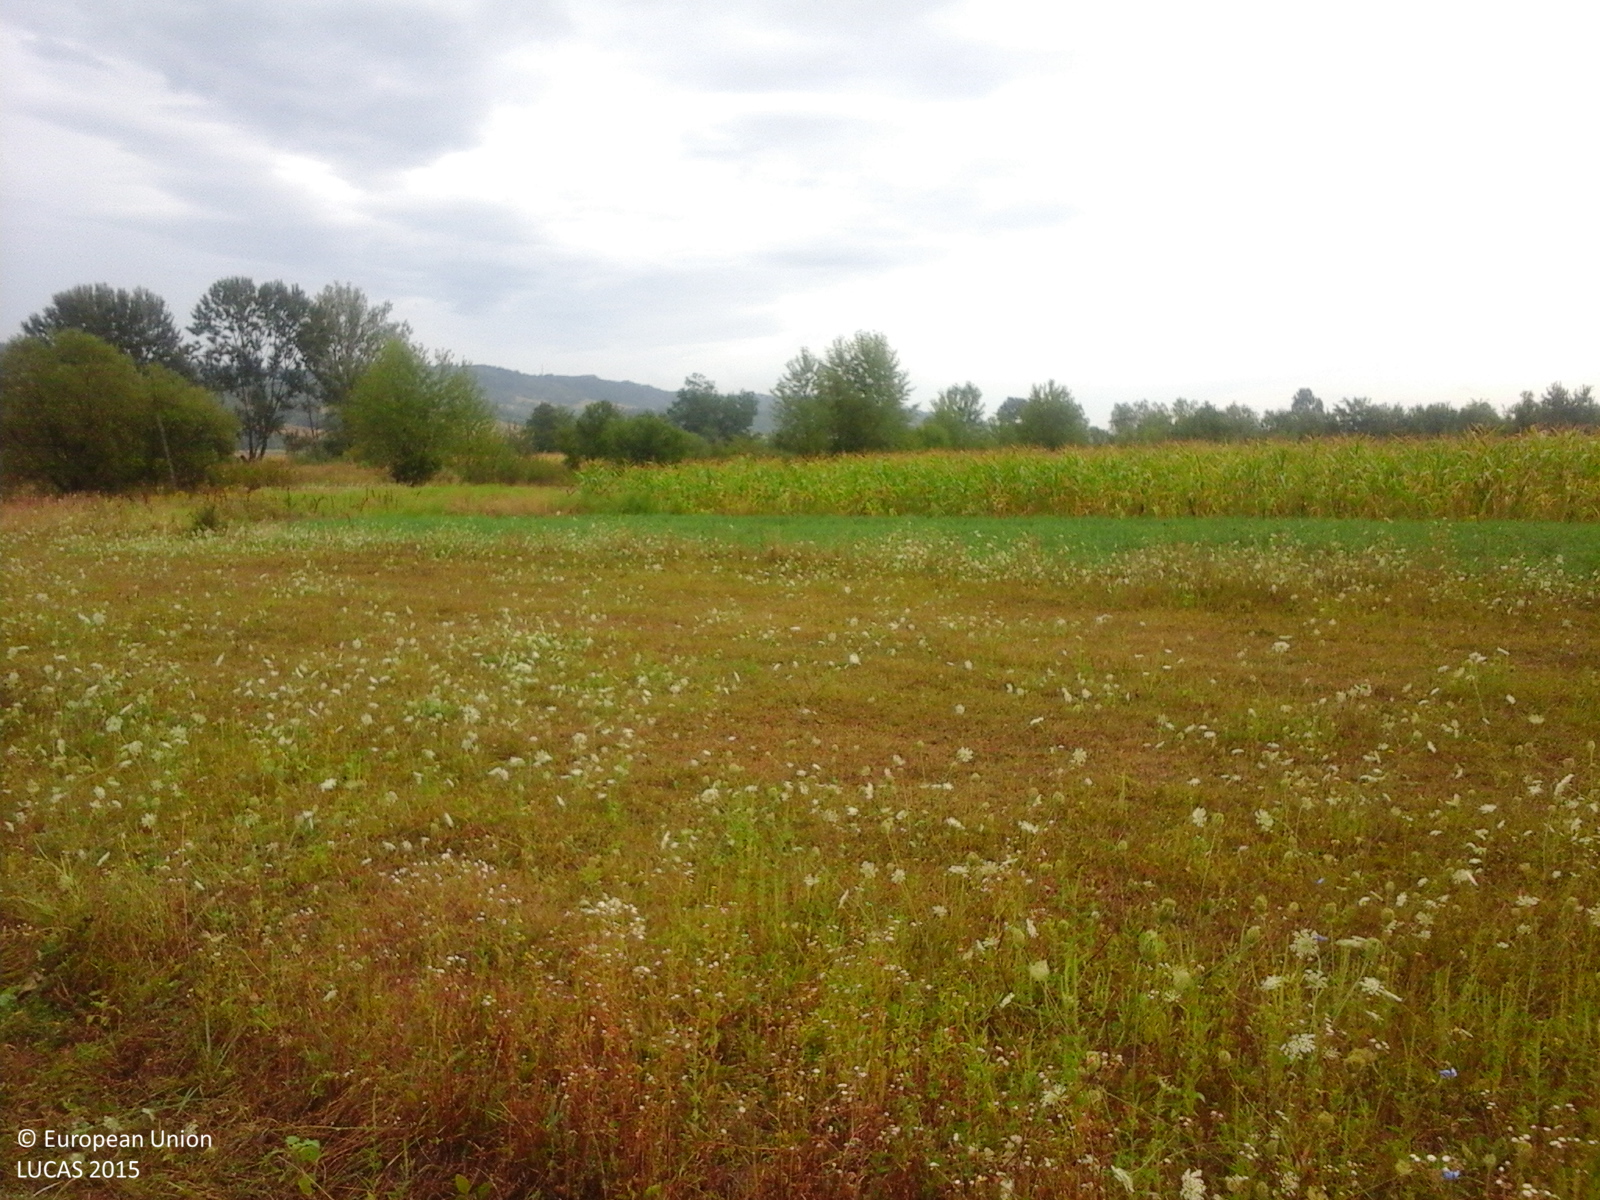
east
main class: Cropland
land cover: Lucerne
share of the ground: > 75 %
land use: Agriculture (excluding fallow land and kitchen gardens)
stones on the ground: < 10 %
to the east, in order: Lucerne; Grassland without tree/shrub cover; Lucerne; Spontaneously vegetated surfaces; Tracks; Grass margins; Abandoned hedges; Ditches and canals; Grass margins; Tracks; Spontaneously vegetated surfaces; Abandoned hedges; Inland fresh running water; Abandoned hedges; Tracks; Arable land (only in case pi)
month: August
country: RO
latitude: 44.7291
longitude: 22.8867
